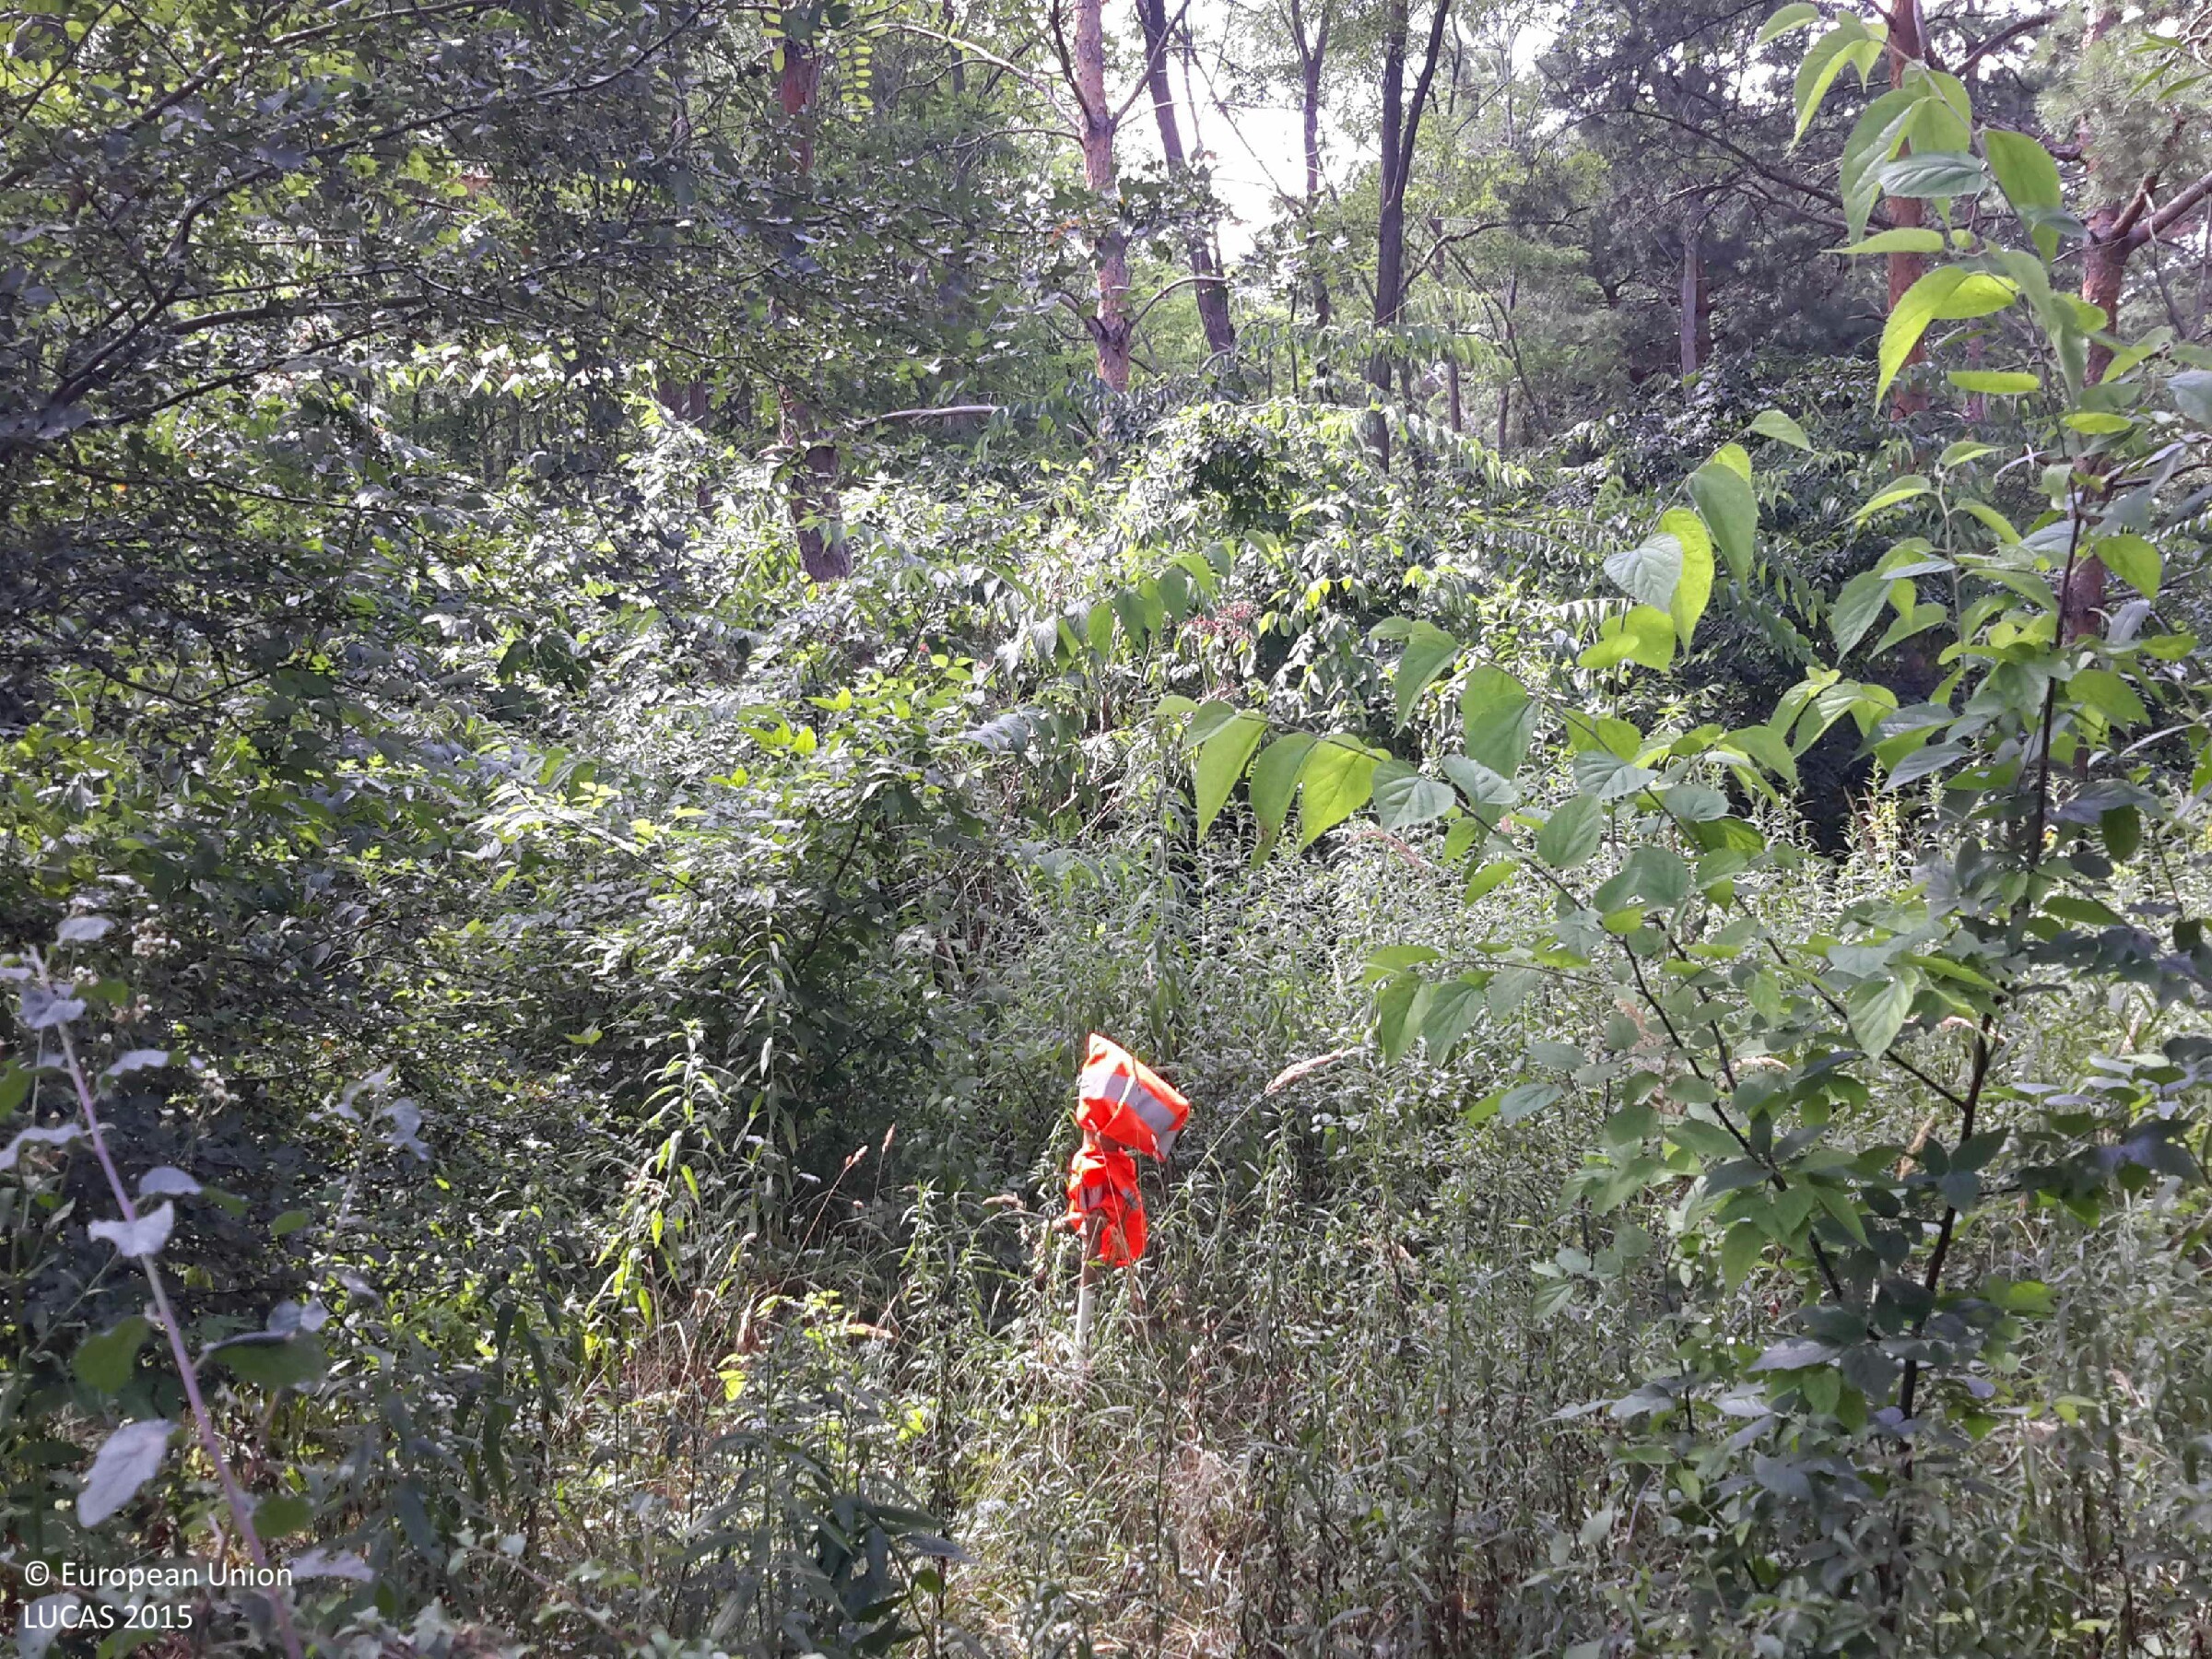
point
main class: Woodland
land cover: Broadleaved woodland
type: mesophytic deciduous forest
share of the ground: 50 - 75 %
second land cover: Spontaneously vegetated surfaces
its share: 25 - 50 %
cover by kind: broadleaved forest trees 70 %, shrubs 20 %, herbaceous plants 10 %
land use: Forestry
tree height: > 5 m
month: July
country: HU
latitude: 47.7235
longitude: 17.8899
